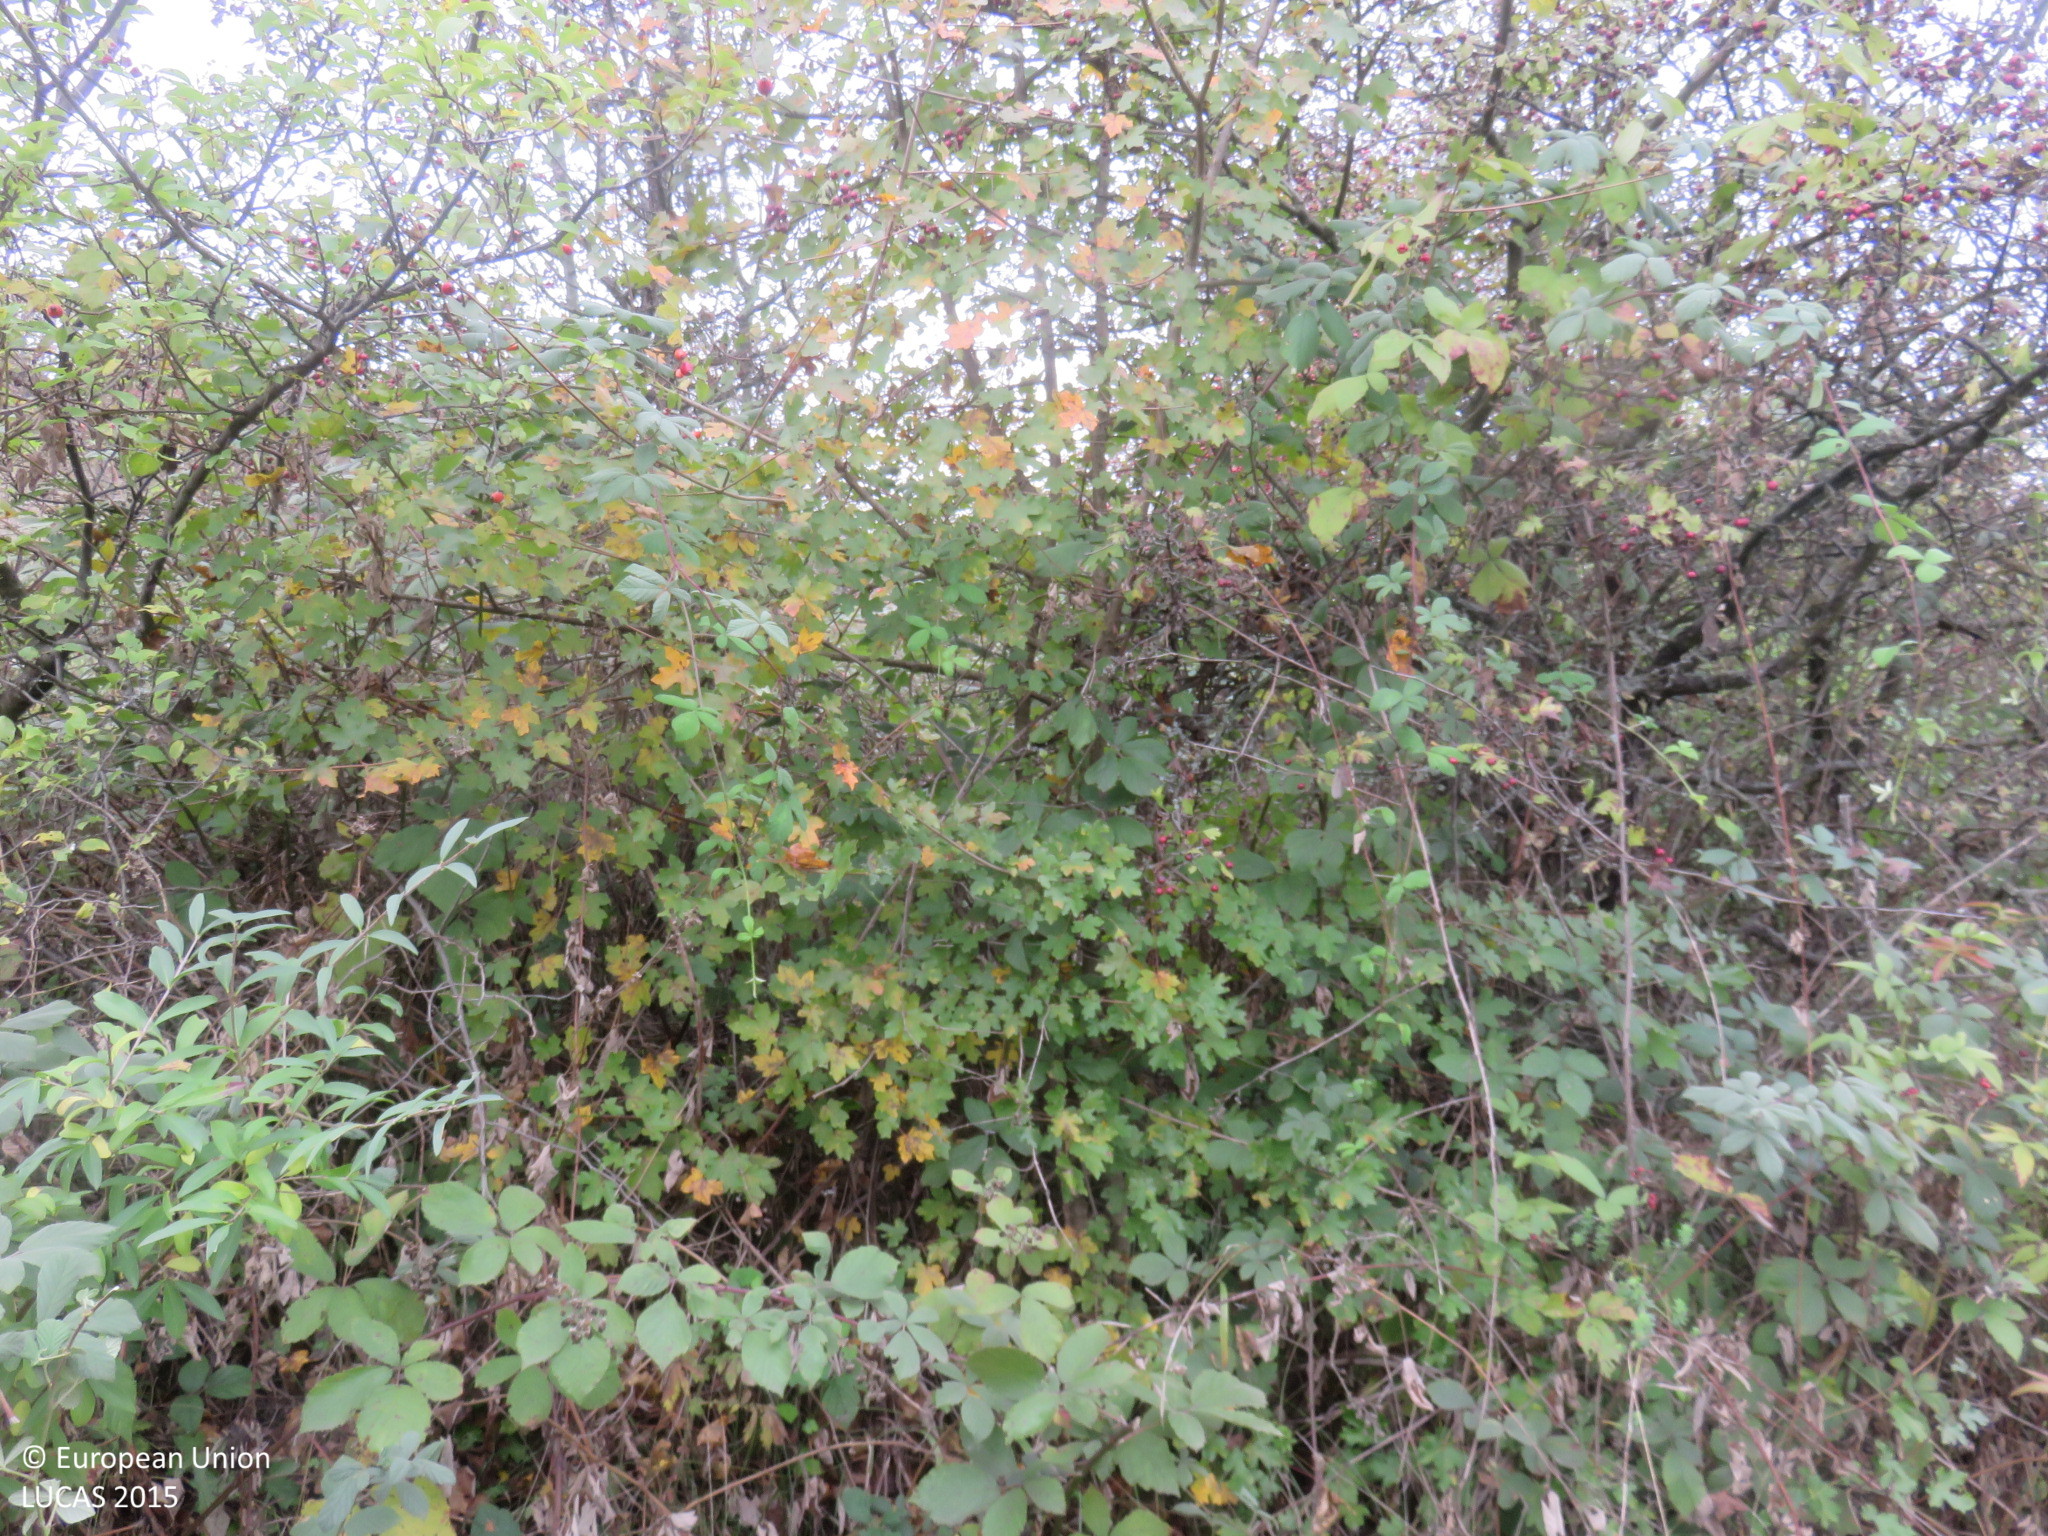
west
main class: Shrubland
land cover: Shrubland with sparse tree cover
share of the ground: > 75 %
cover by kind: shrubs 90 %, broadleaved forest trees 5 %, herbaceous plants 5 %
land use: Semi-natural and natural areas not in use
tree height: < 5 m
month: October
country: BG
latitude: 42.9331
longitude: 25.1771
